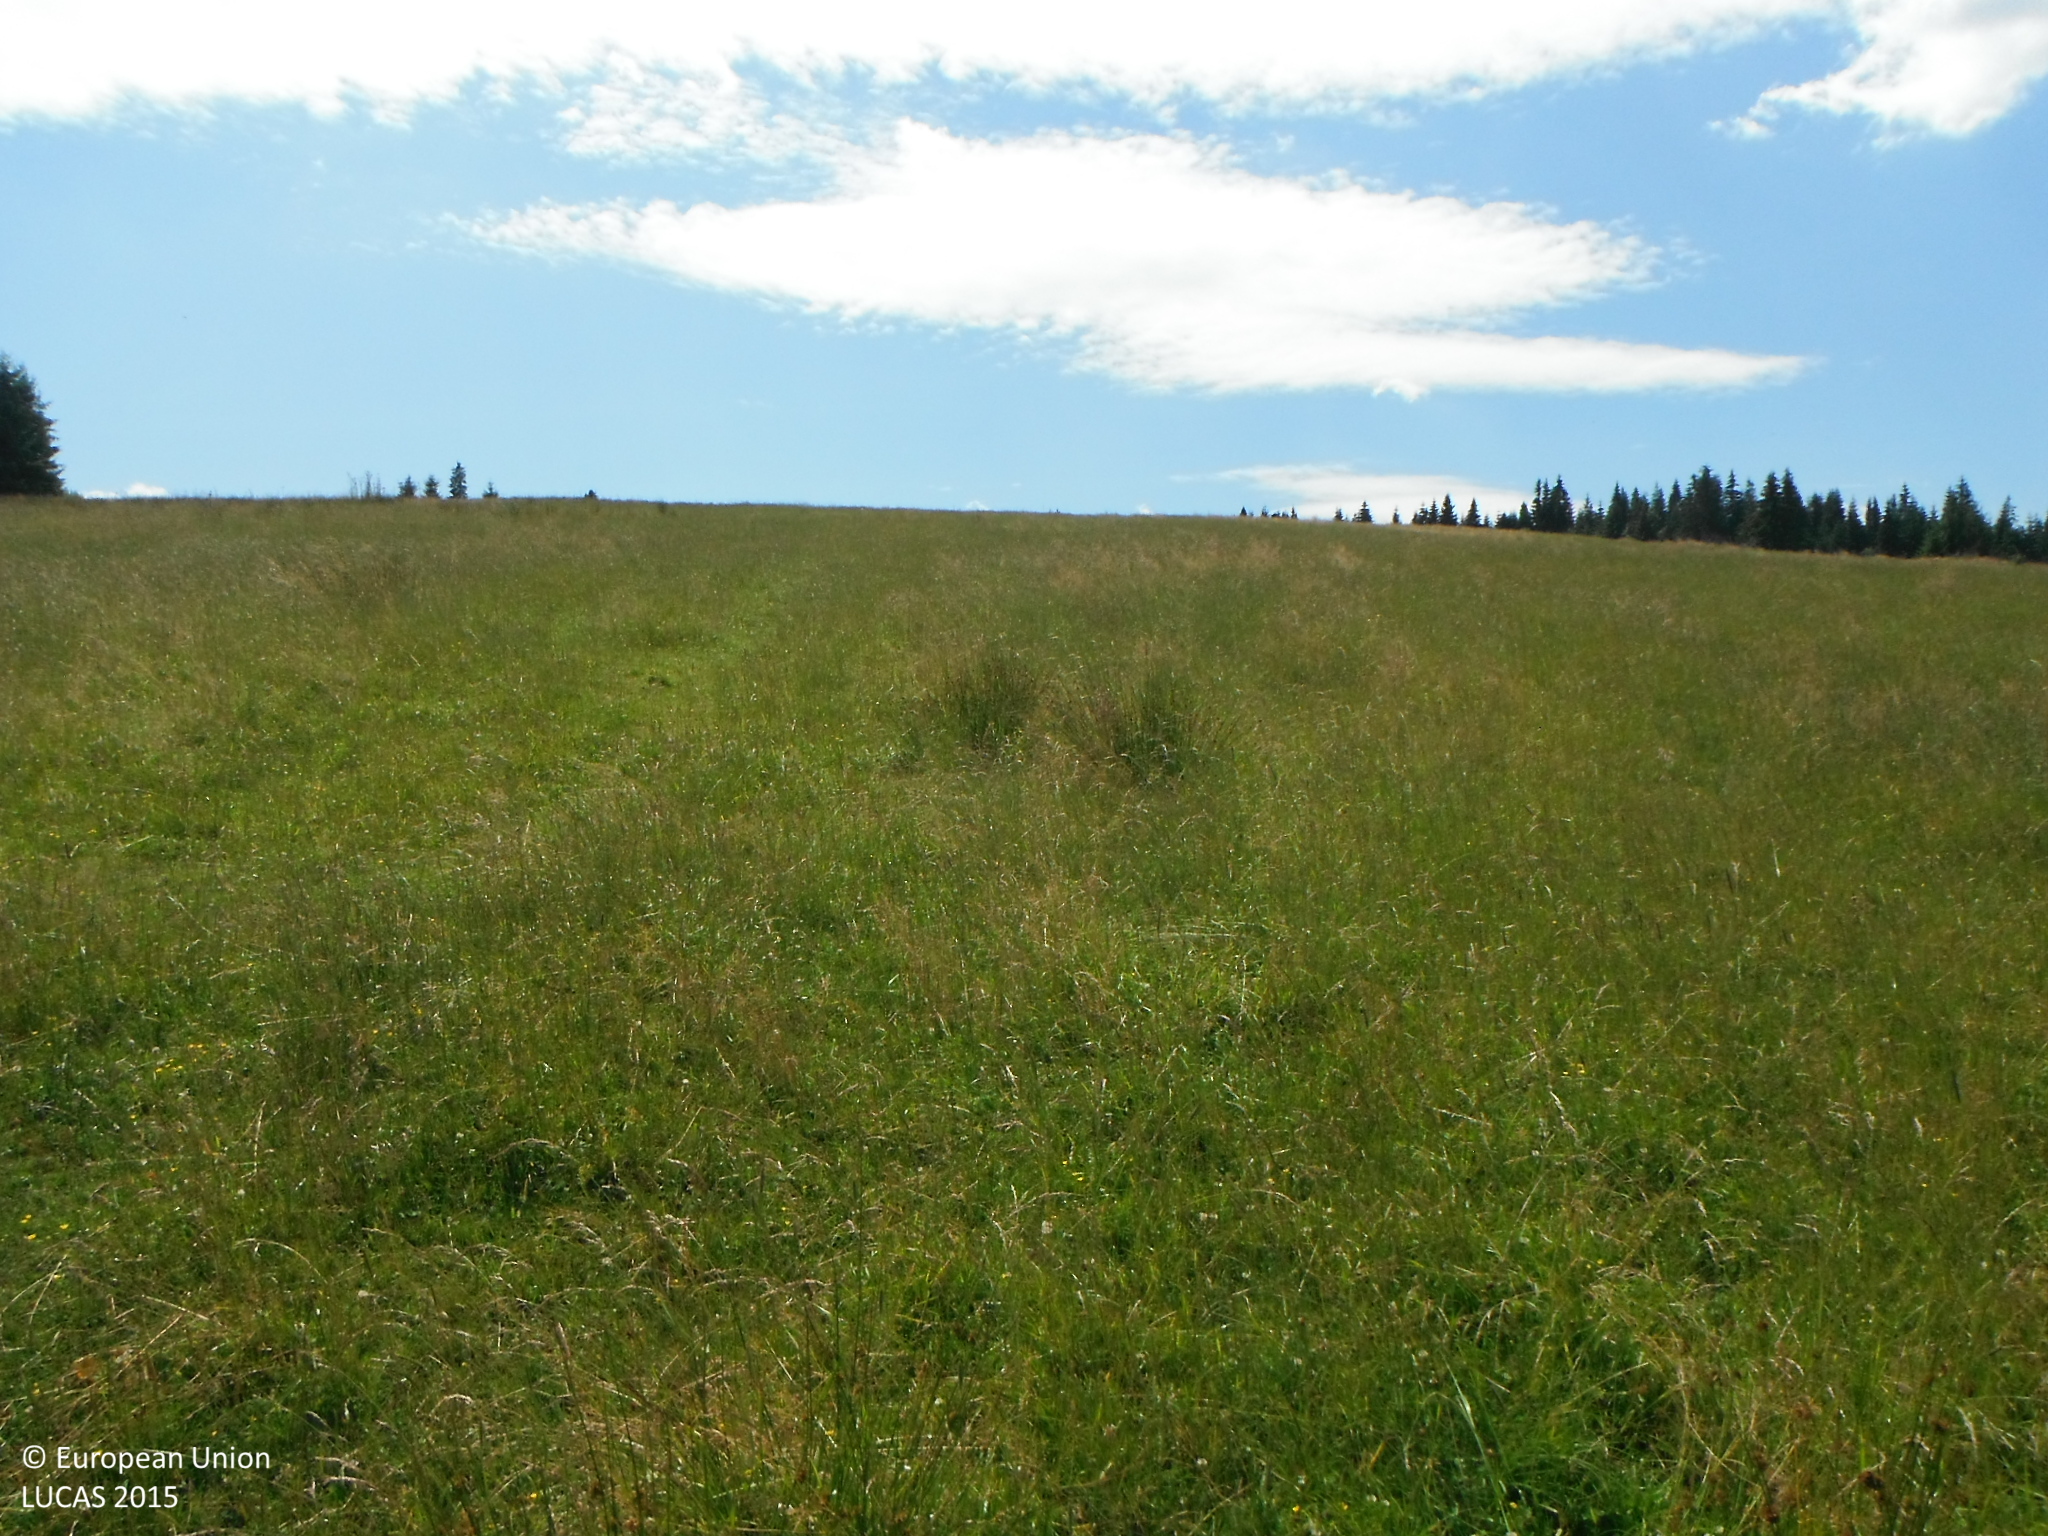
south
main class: Grassland
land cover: Grassland without tree/shrub cover
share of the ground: > 75 %
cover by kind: herbaceous plants 100 %
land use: Agriculture (excluding fallow land and kitchen gardens)
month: July
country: SK
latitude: 49.3300
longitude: 19.7573
